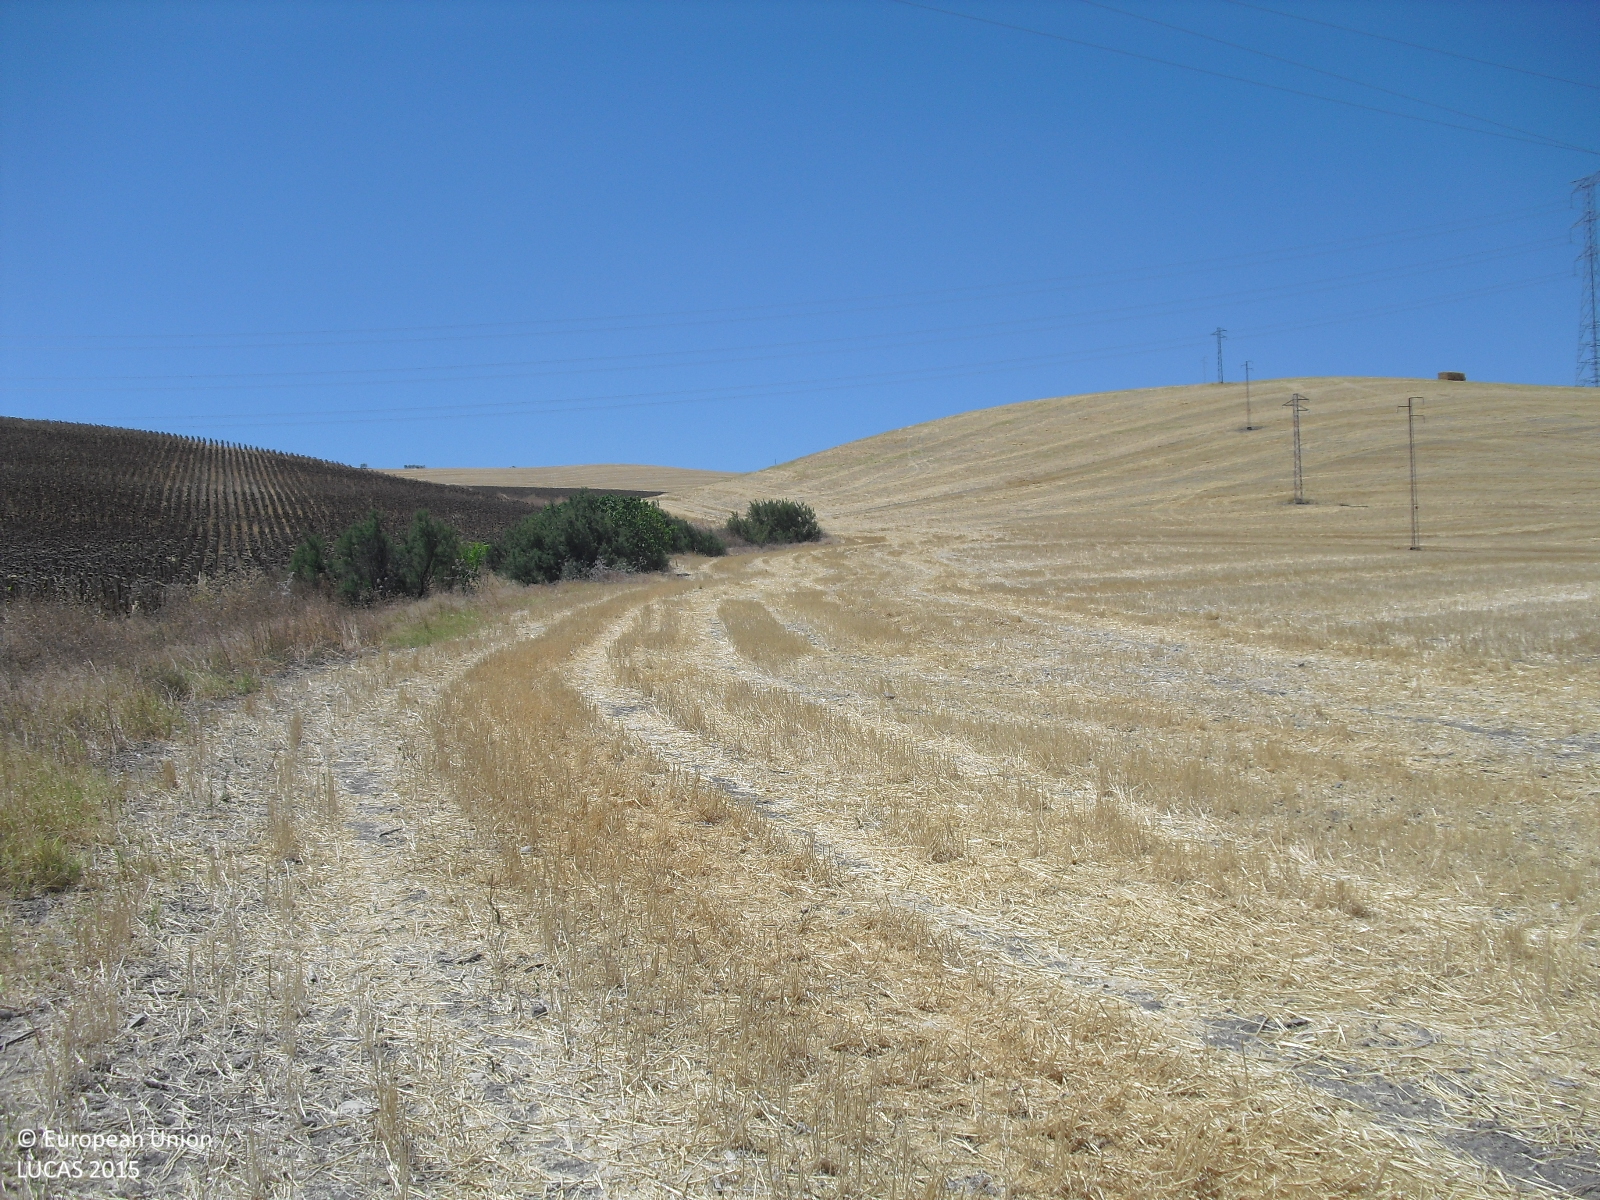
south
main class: Cropland
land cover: Common wheat
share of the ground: < 10 %
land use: Agriculture (excluding fallow land and kitchen gardens)
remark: Harvested field
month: July
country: ES
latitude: 37.0623
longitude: -5.4730
